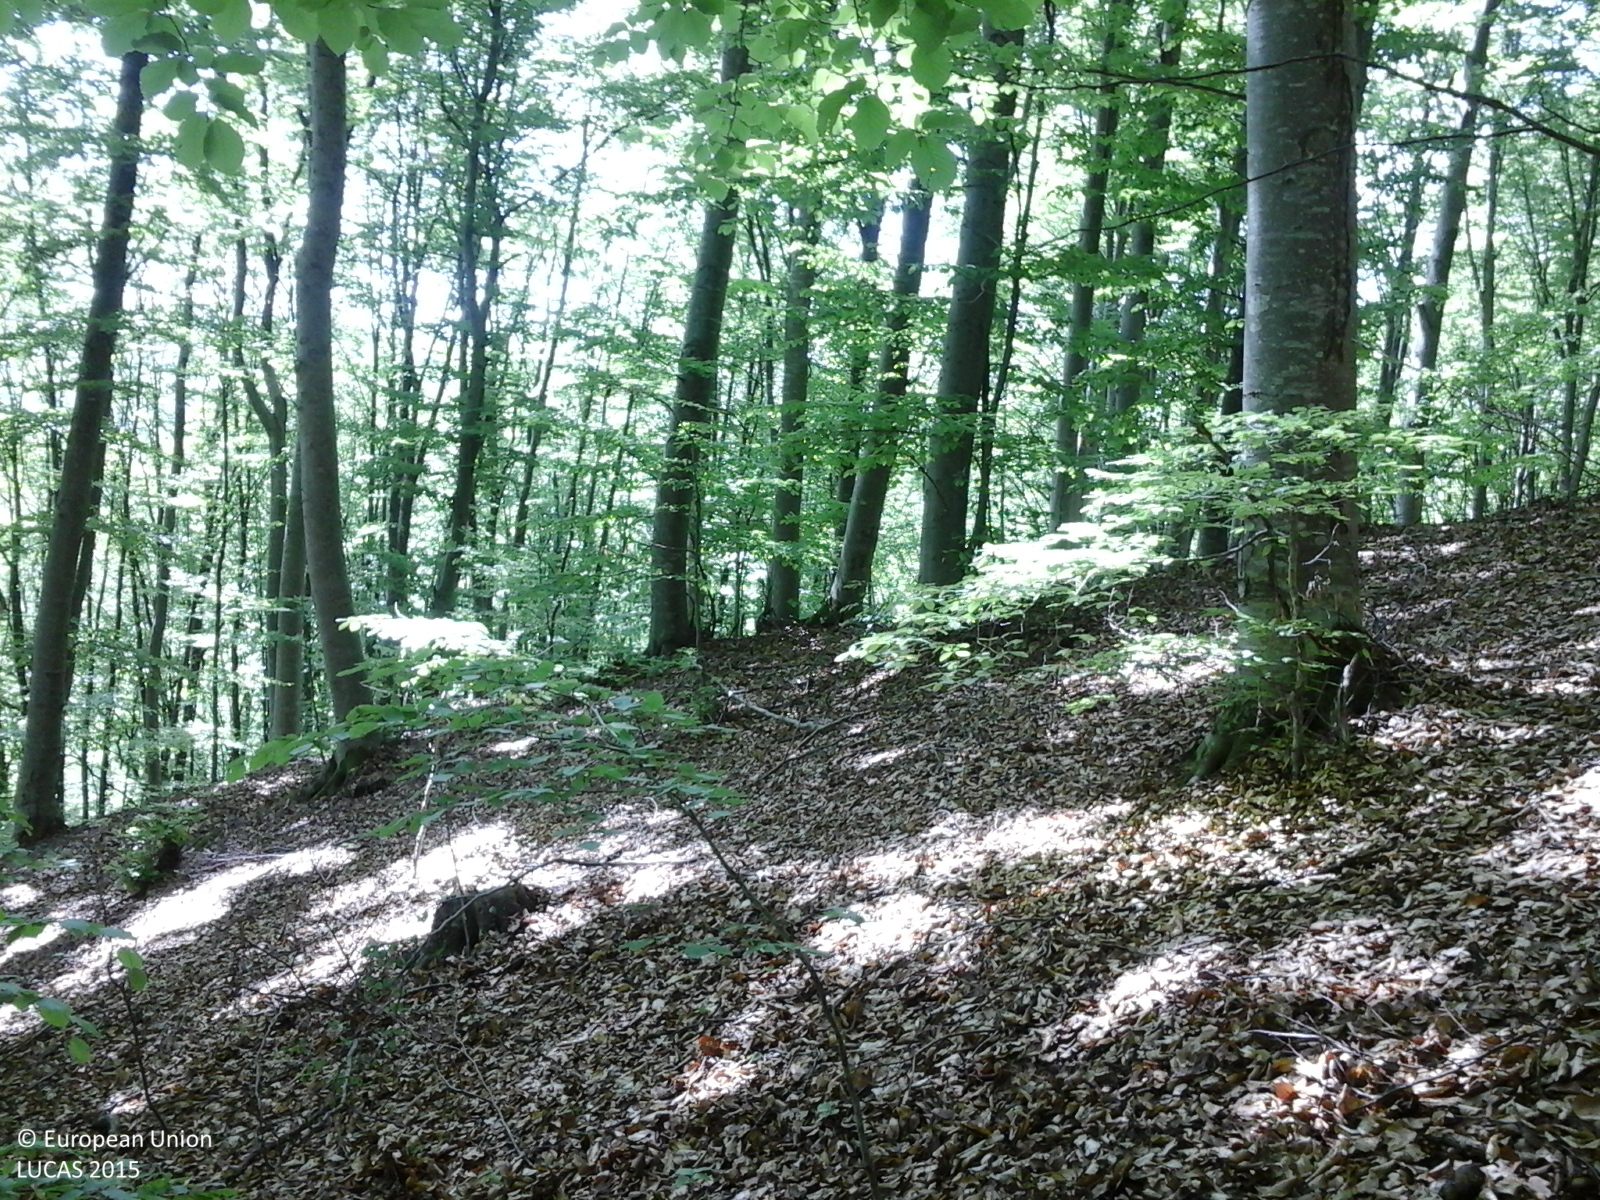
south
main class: Woodland
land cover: Broadleaved woodland
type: beech forest
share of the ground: > 75 %
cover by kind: broadleaved forest trees 100 %
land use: Forestry
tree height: > 5 m
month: May
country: RO
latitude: 45.8563
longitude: 25.7317
